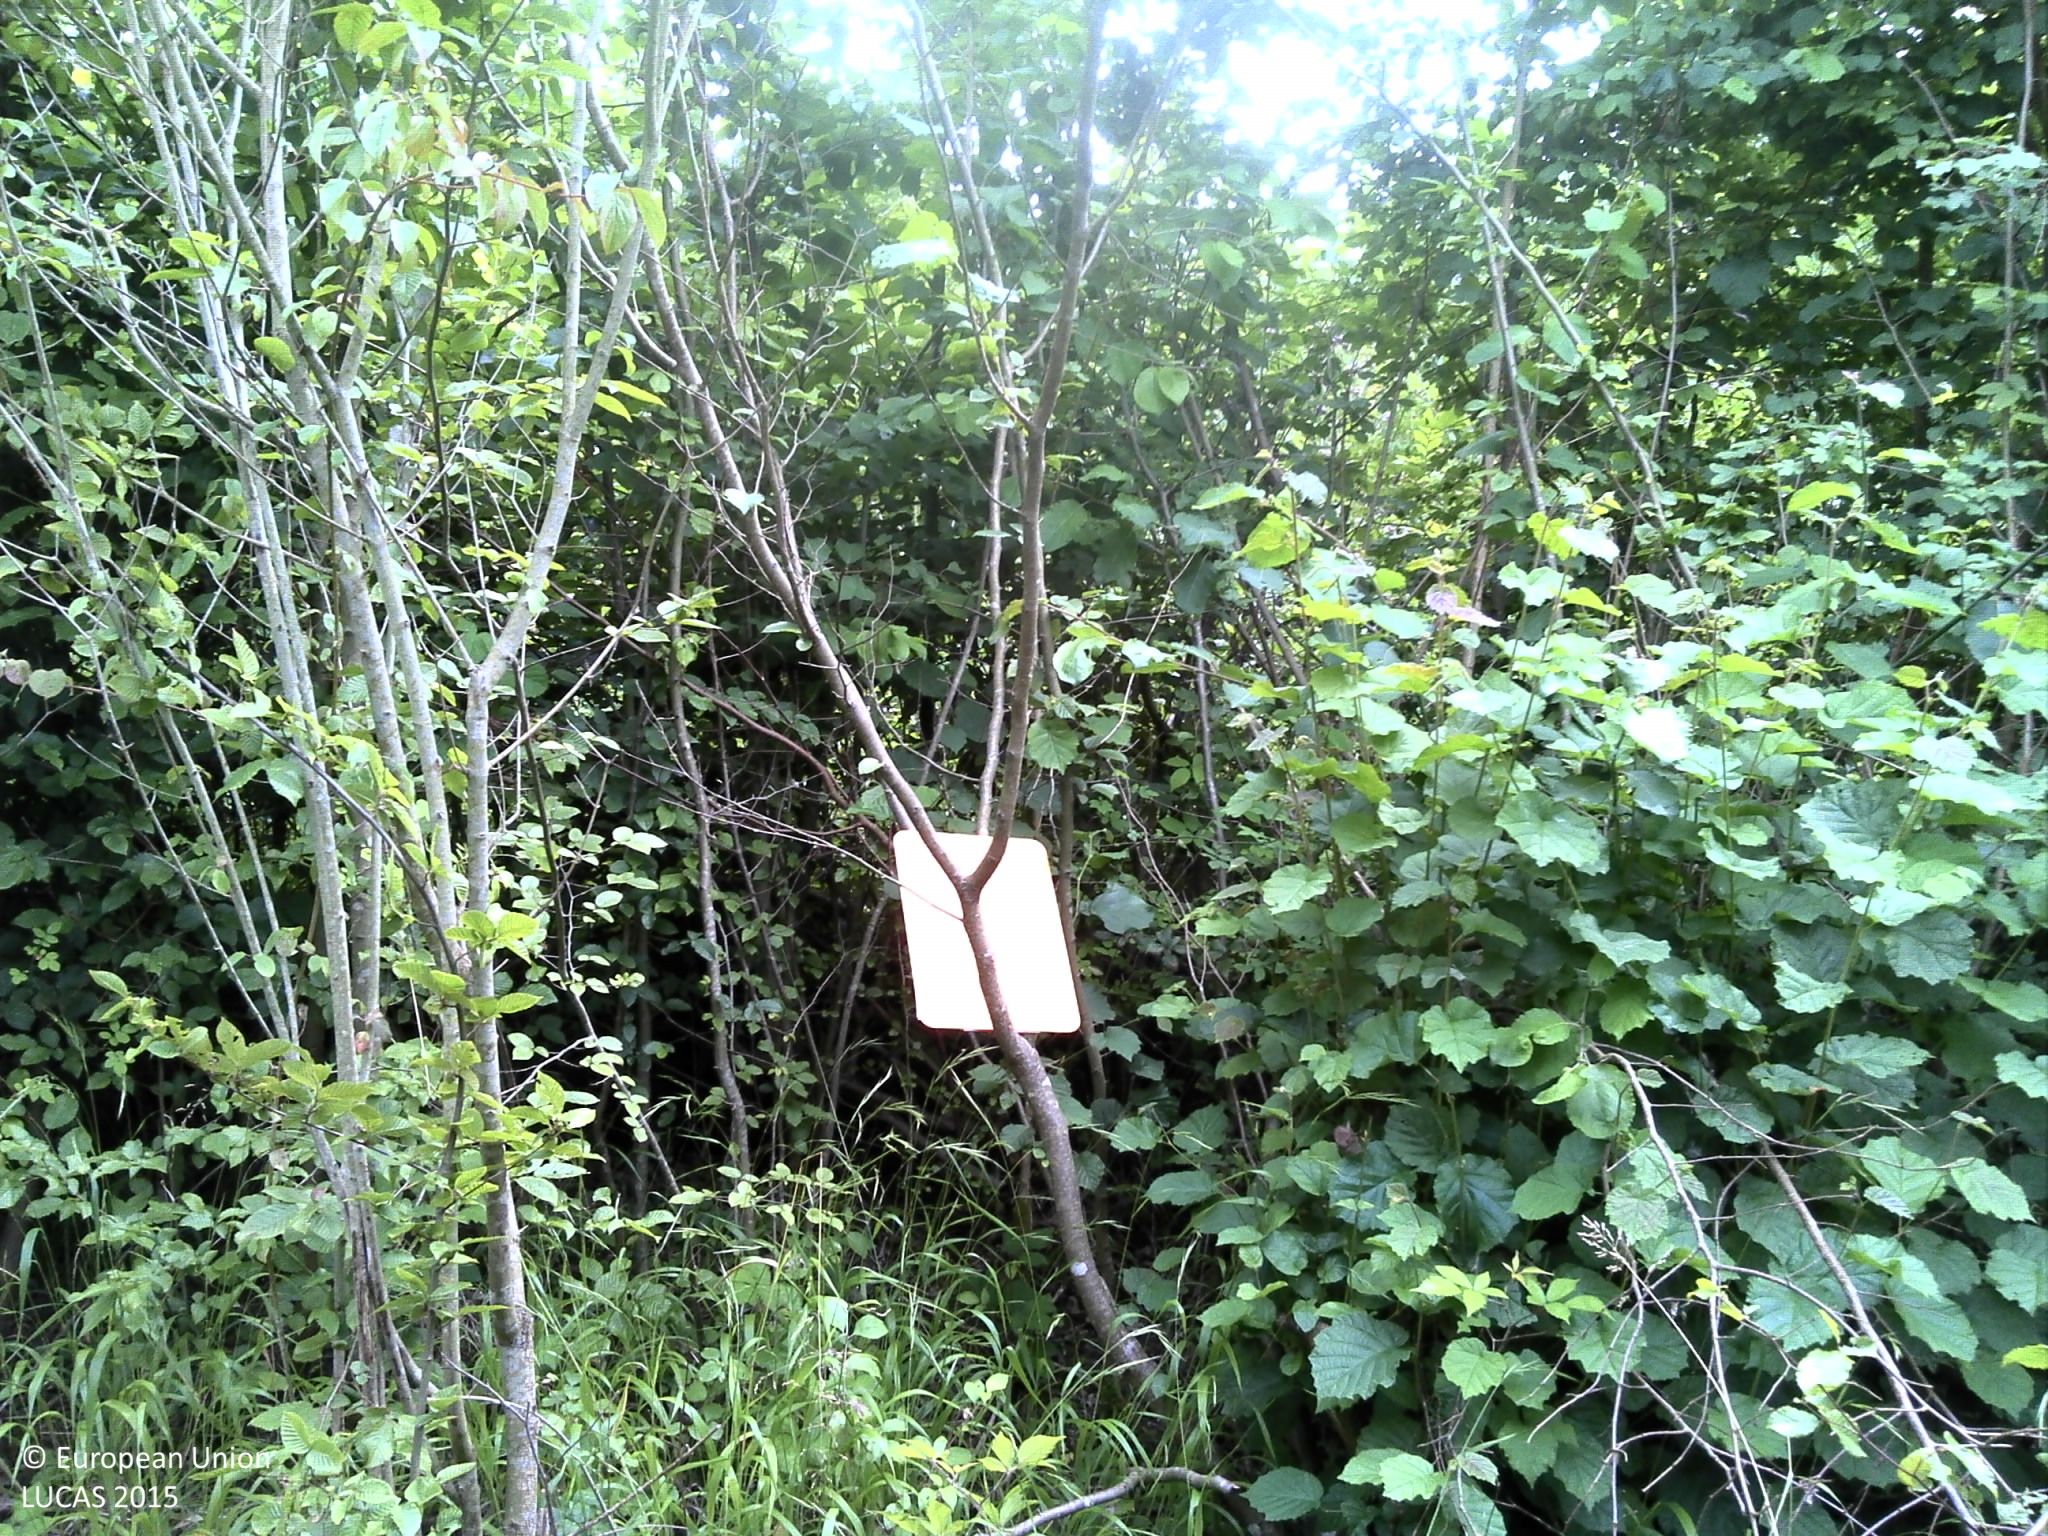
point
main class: Woodland
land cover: Broadleaved woodland
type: mesophytic deciduous forest
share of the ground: > 75 %
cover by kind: broadleaved forest trees 70 %, herbaceous plants 30 %
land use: Forestry
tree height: > 5 m
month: June
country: FR
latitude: 49.2754
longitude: 6.2198
